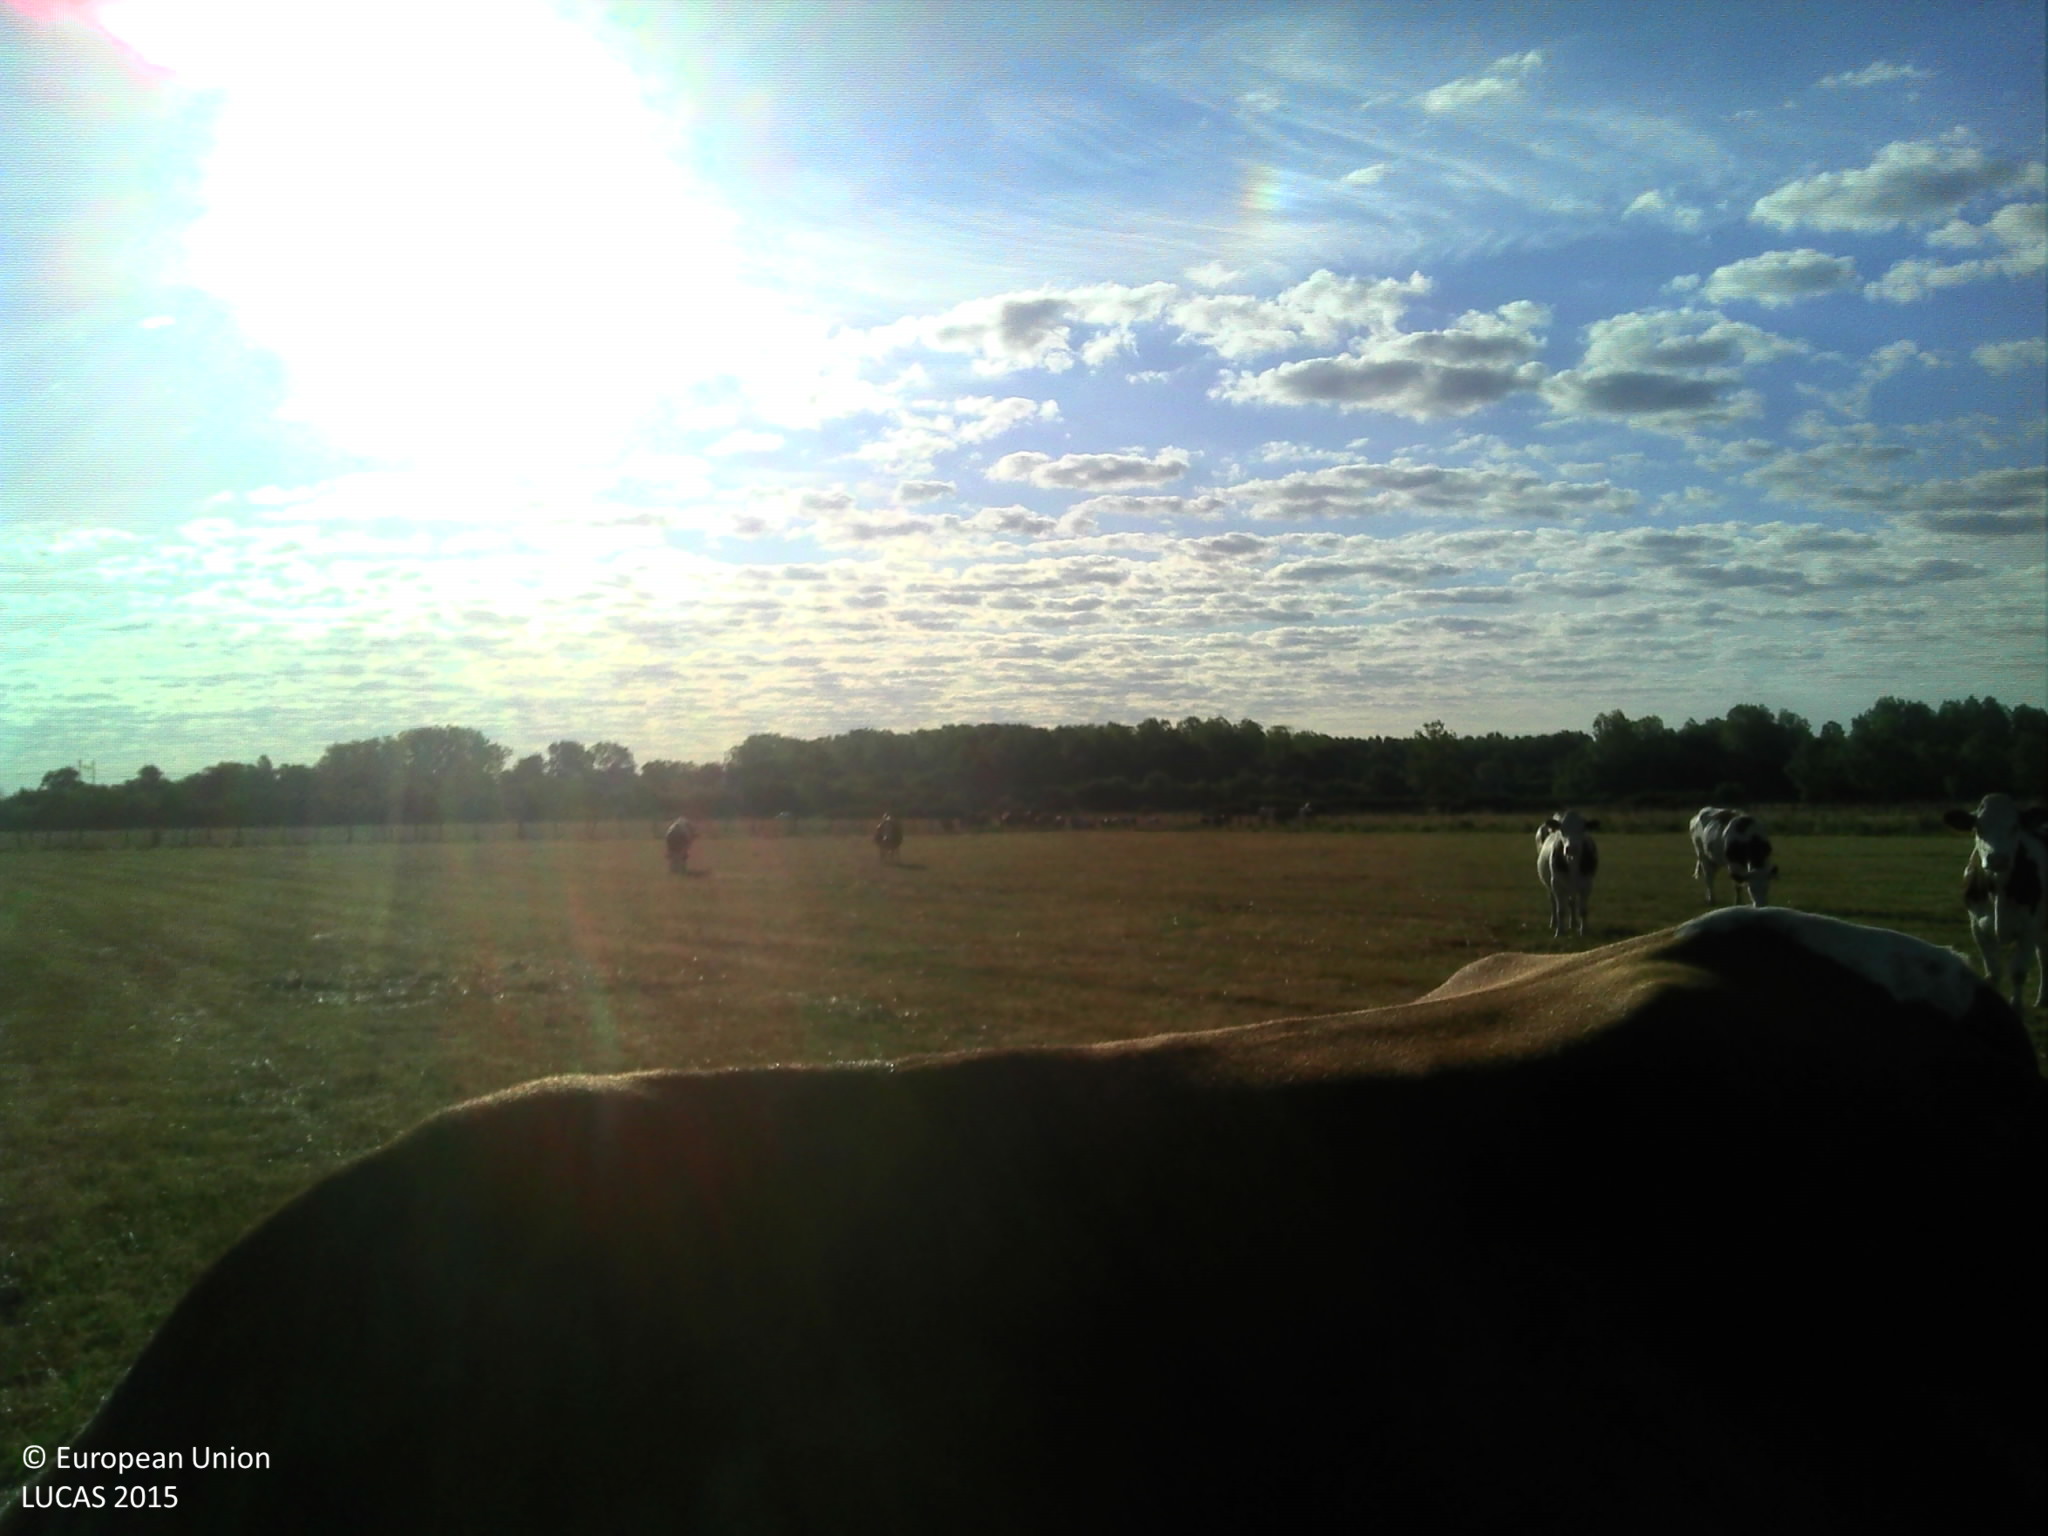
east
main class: Grassland
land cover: Grassland without tree/shrub cover
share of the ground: > 75 %
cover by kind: herbaceous plants 100 %
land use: Agriculture (excluding fallow land and kitchen gardens)
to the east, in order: Grassland without tree/shrub cover; Fences; Grassland without tree/shrub cover
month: July
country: FR
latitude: 46.6790
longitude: 4.8638
